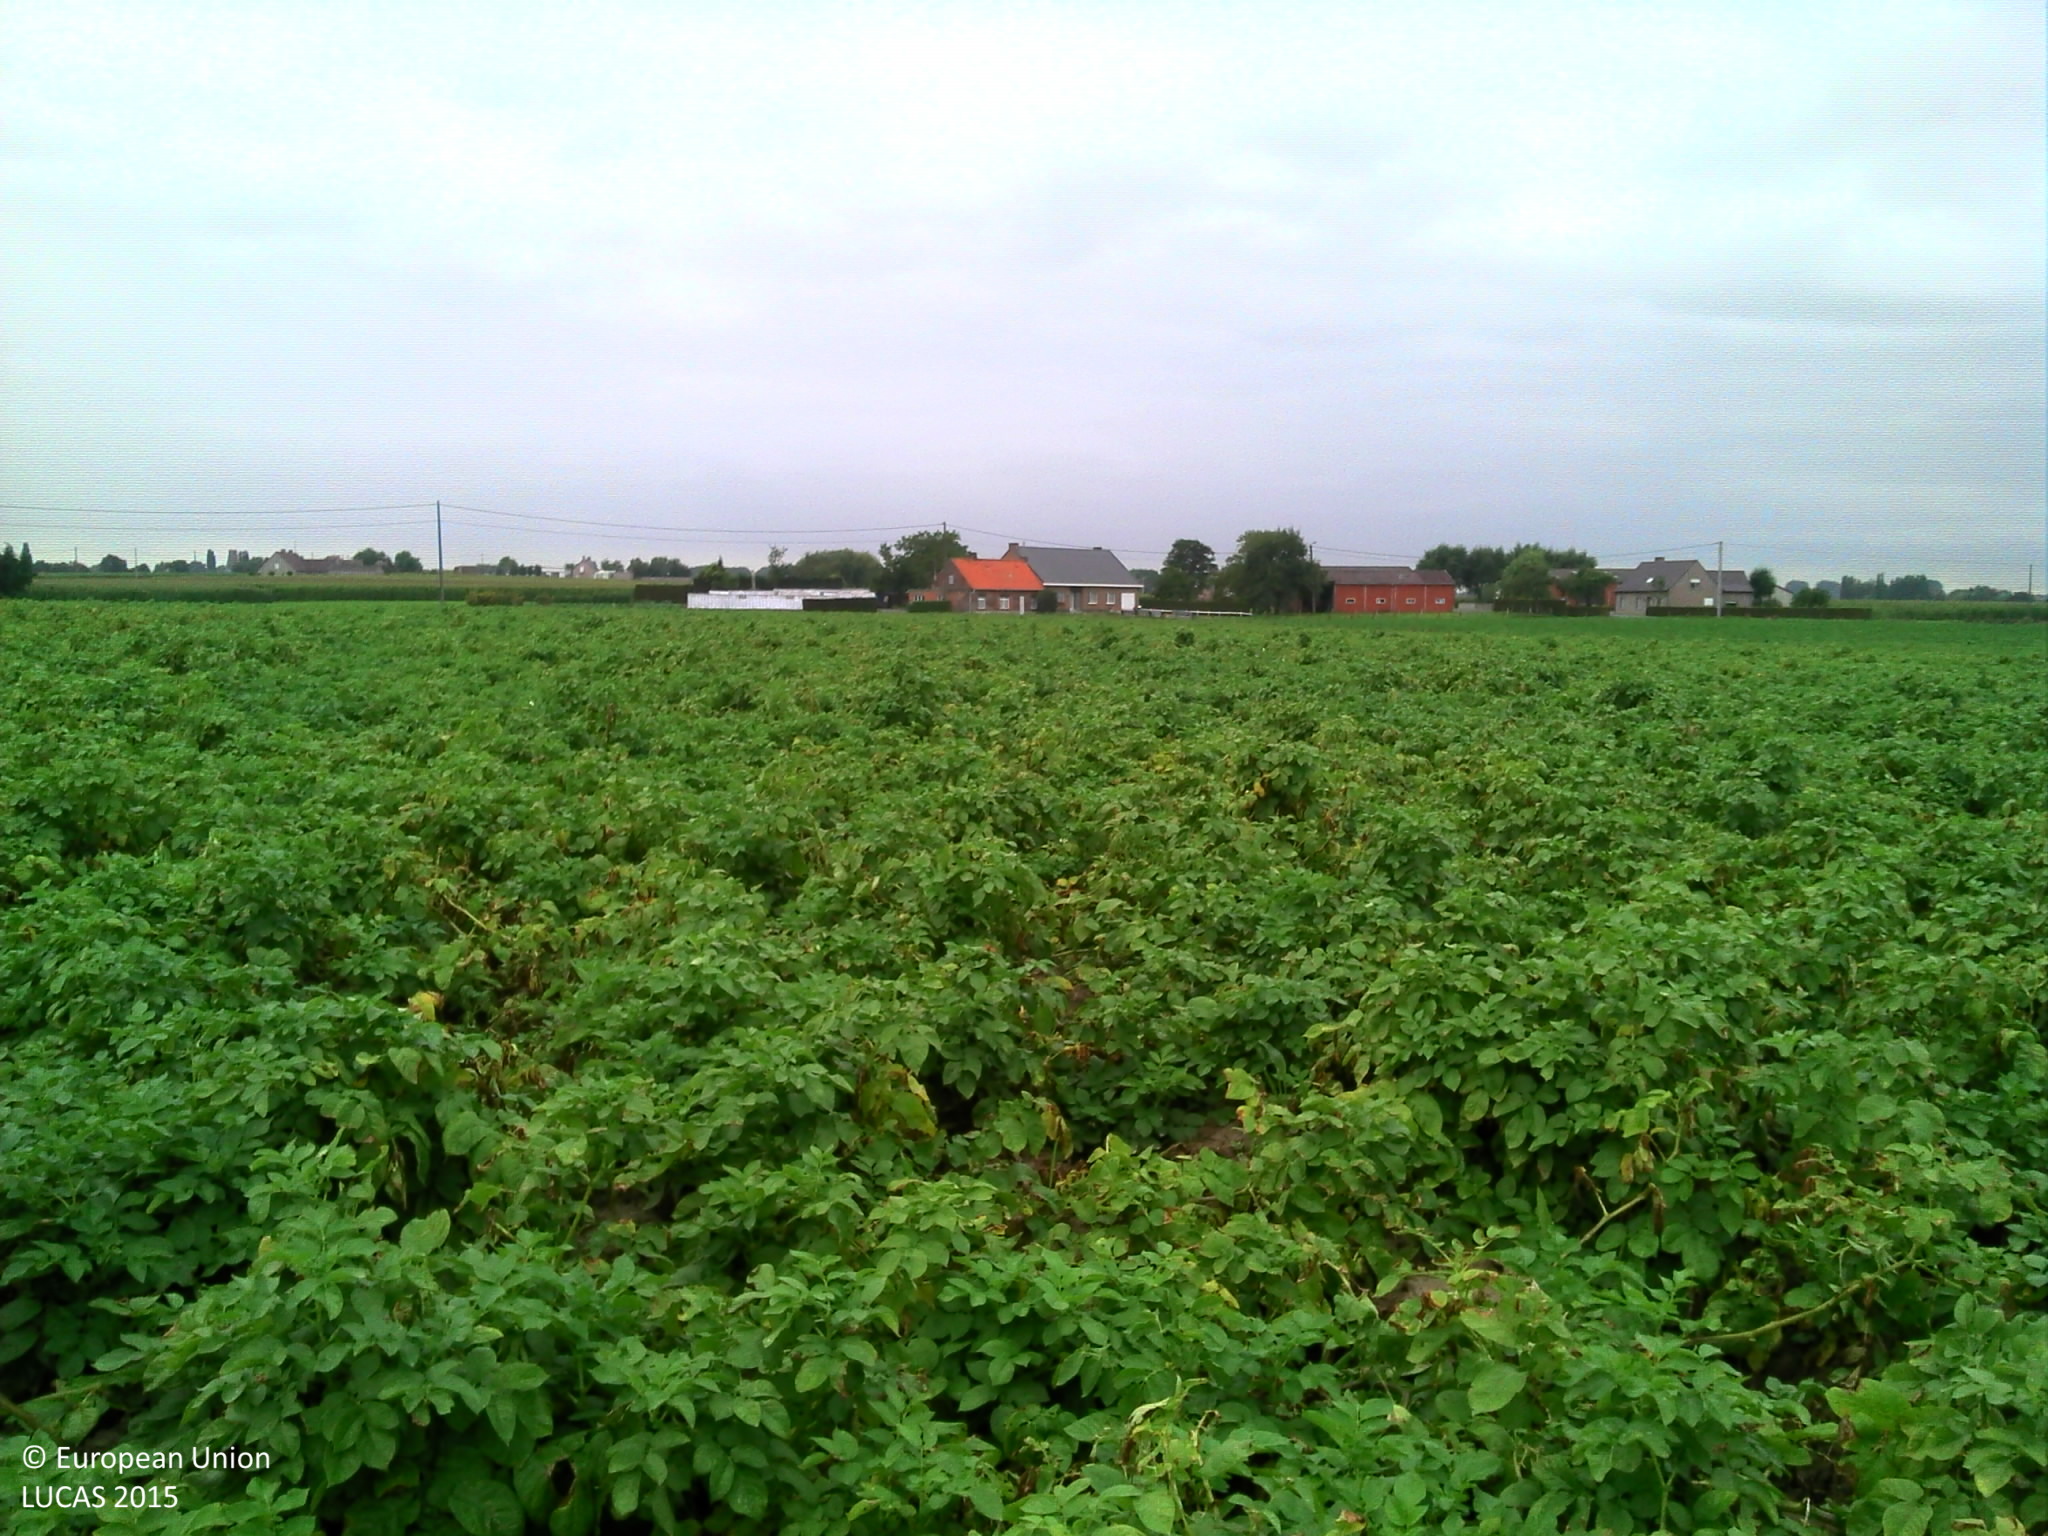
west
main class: Cropland
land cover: Potatoes
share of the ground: > 75 %
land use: Agriculture (excluding fallow land and kitchen gardens)
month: September
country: BE
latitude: 51.0062
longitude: 3.4505
